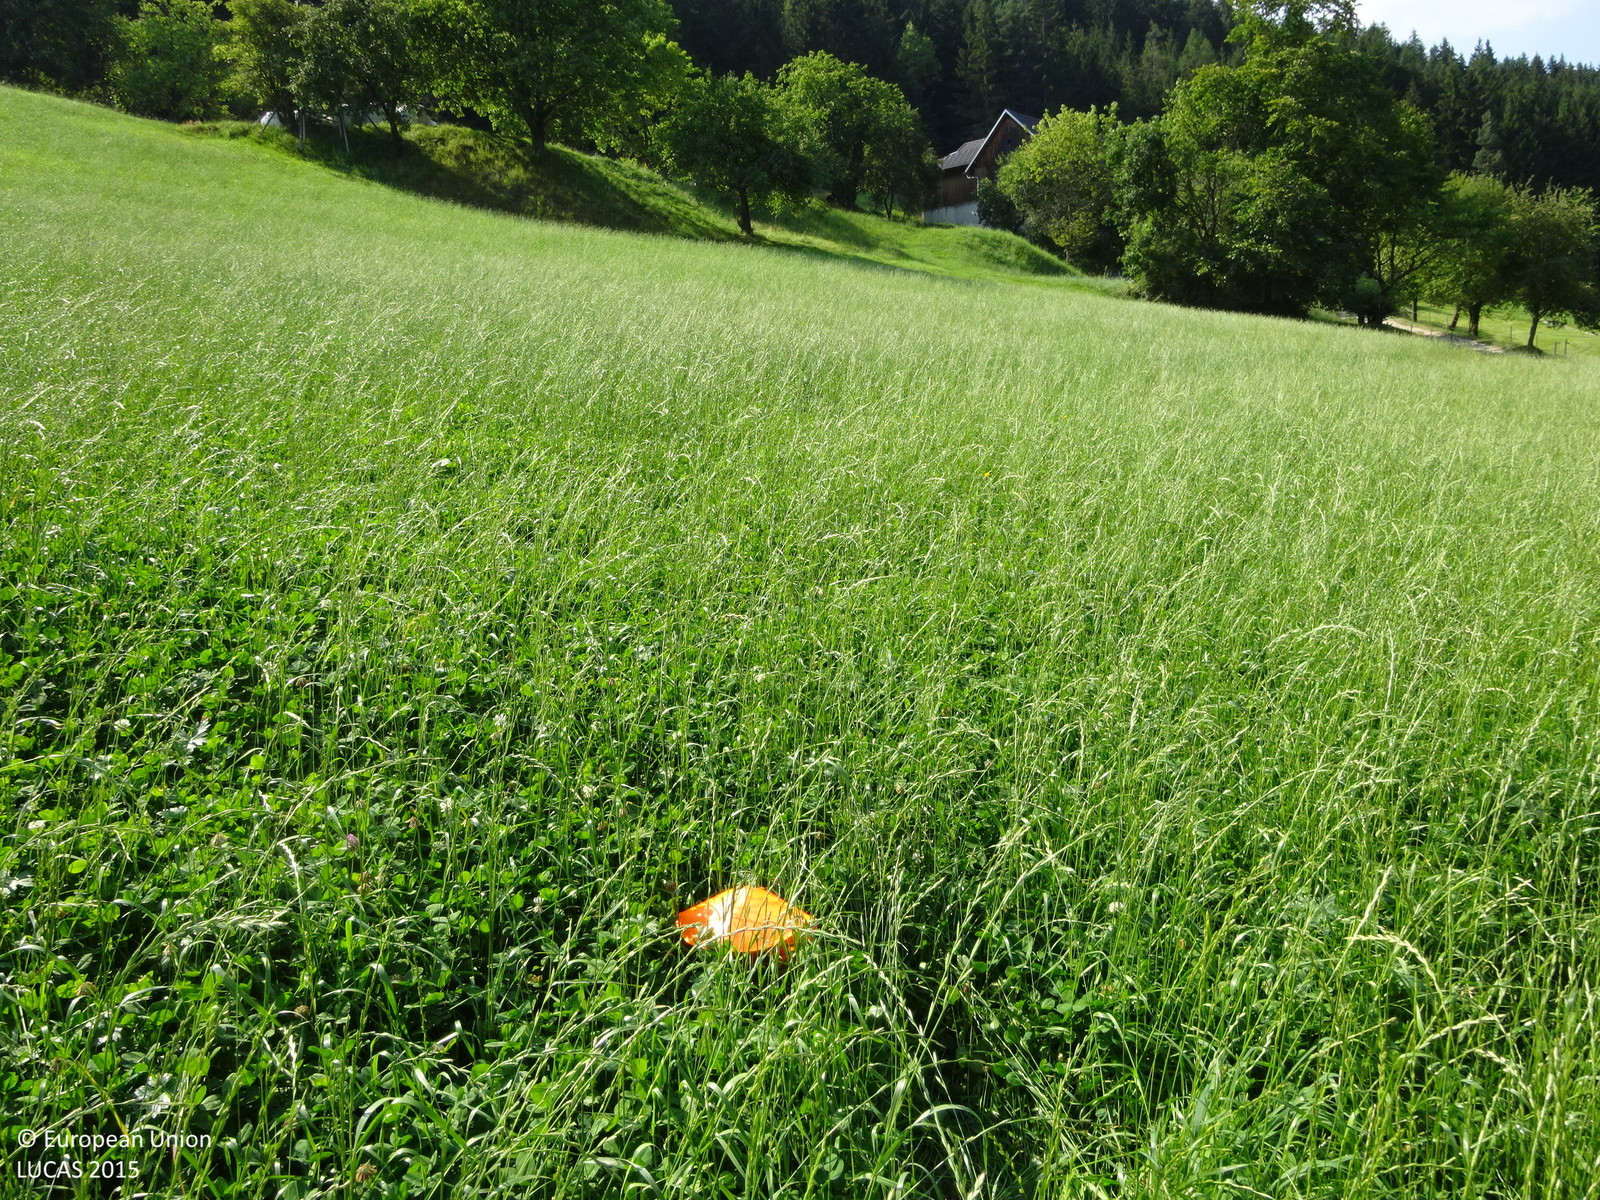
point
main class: Grassland
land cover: Grassland without tree/shrub cover
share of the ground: > 75 %
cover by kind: herbaceous plants 100 %
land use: Agriculture (excluding fallow land and kitchen gardens)
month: August
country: AT
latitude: 47.4272
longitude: 15.6884
